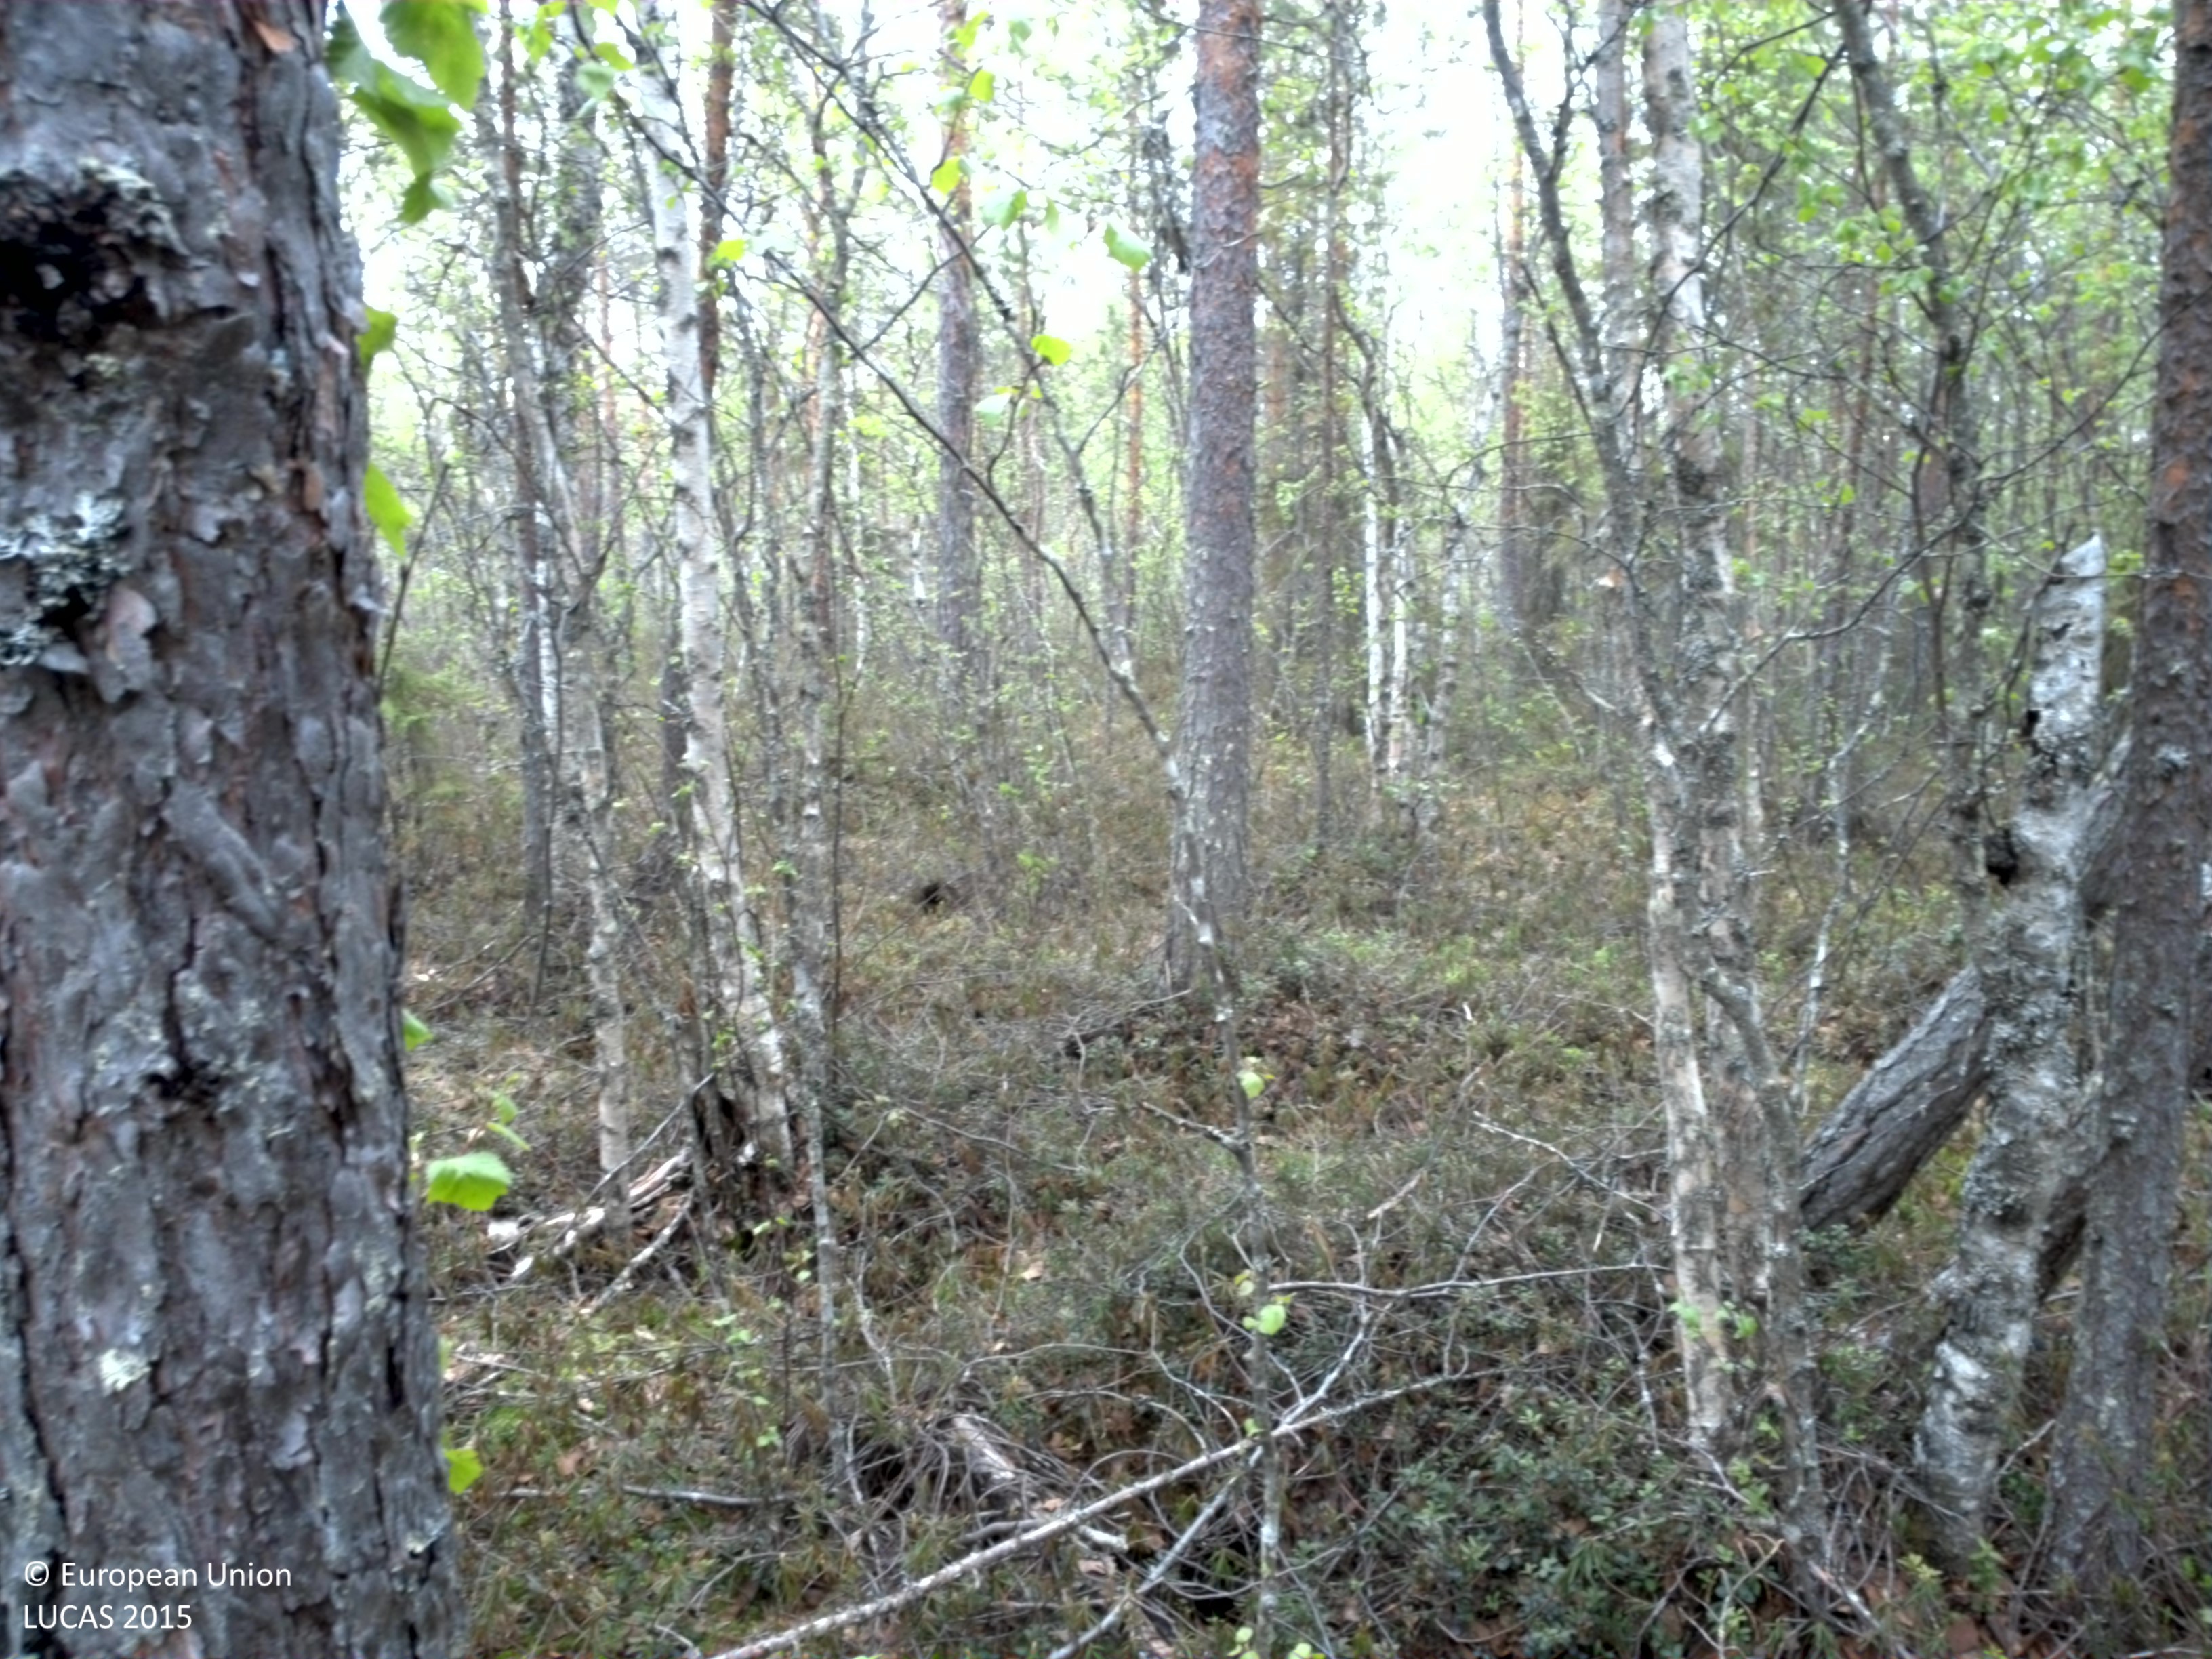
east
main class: Woodland
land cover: Pine dominated mixed woodland
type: boreal forest
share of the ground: > 75 %
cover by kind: coniferous forest trees 45 %, broadleaved forest trees 40 %, shrubs 15 %
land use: Forestry
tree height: > 5 m
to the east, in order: Pine dominated mixed woodland; Ditches and canals; Pine dominated mixed woodland; Spruce dominated mixed woodland; Pine dominated mixed woodland; Ditches and canals; Pine dominated mixed woodland; Ditches and canals; Pine dominated mixed woodland
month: June
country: SE
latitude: 66.3694
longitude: 22.8778
